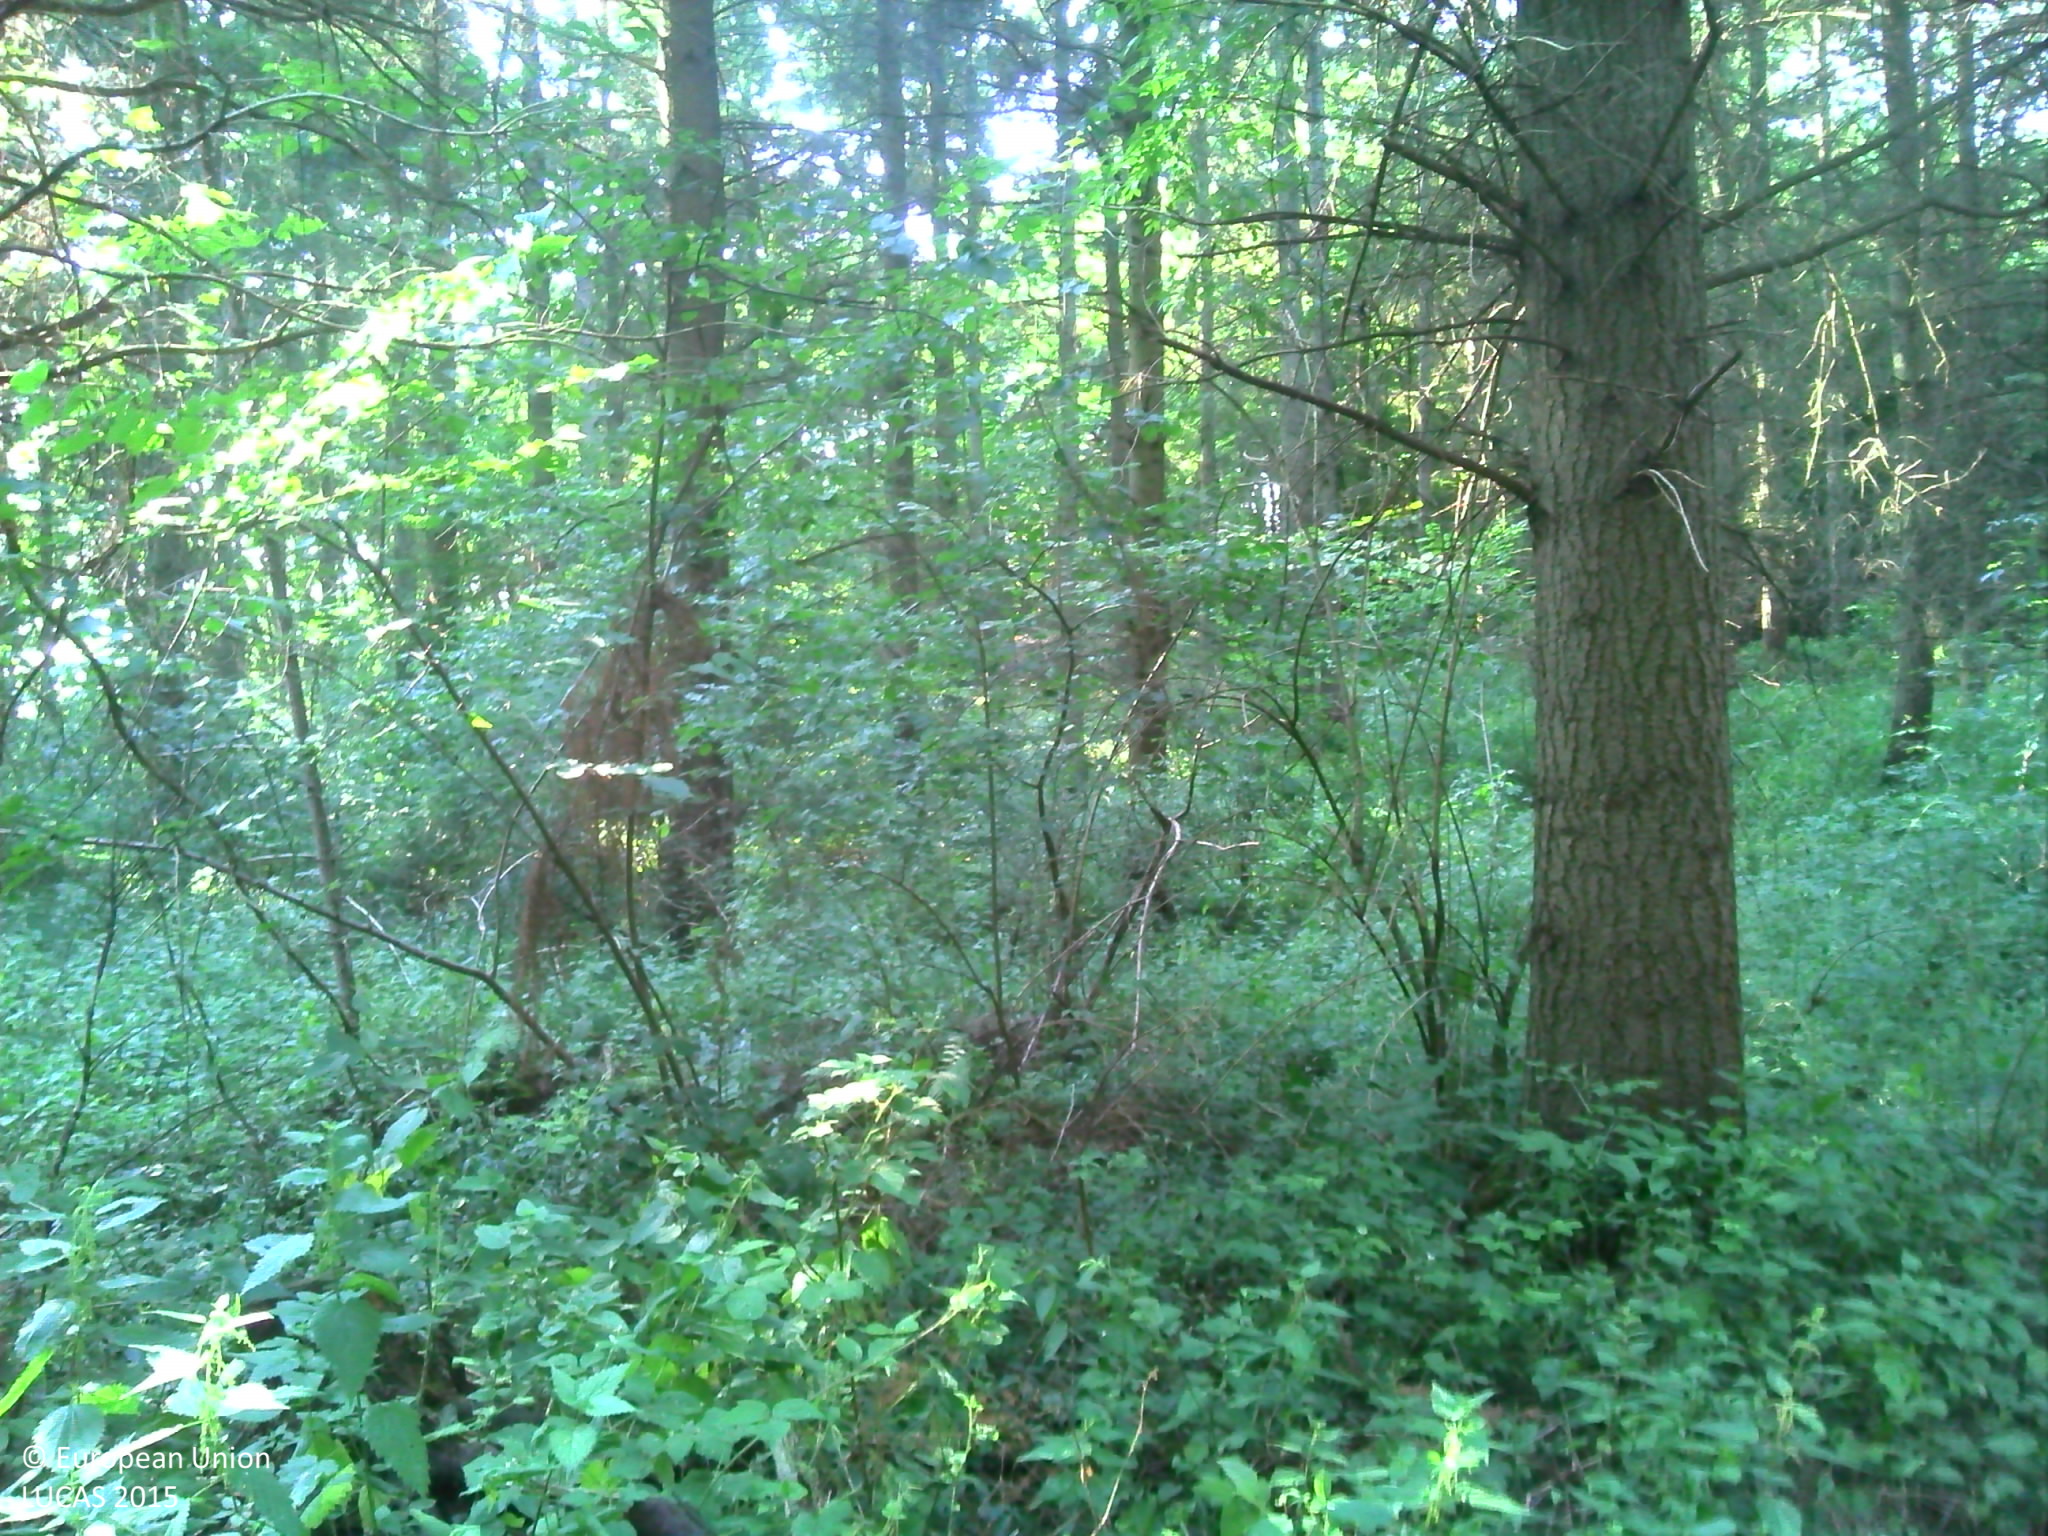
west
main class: Woodland
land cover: Spruce dominated mixed woodland
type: mesophytic deciduous forest
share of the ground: > 75 %
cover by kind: coniferous forest trees 45 %, broadleaved forest trees 20 %, consolidated bare surface 20 %, herbaceous plants 15 %
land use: Forestry
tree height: > 5 m
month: July
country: FR
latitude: 48.8761
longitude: 1.3229
